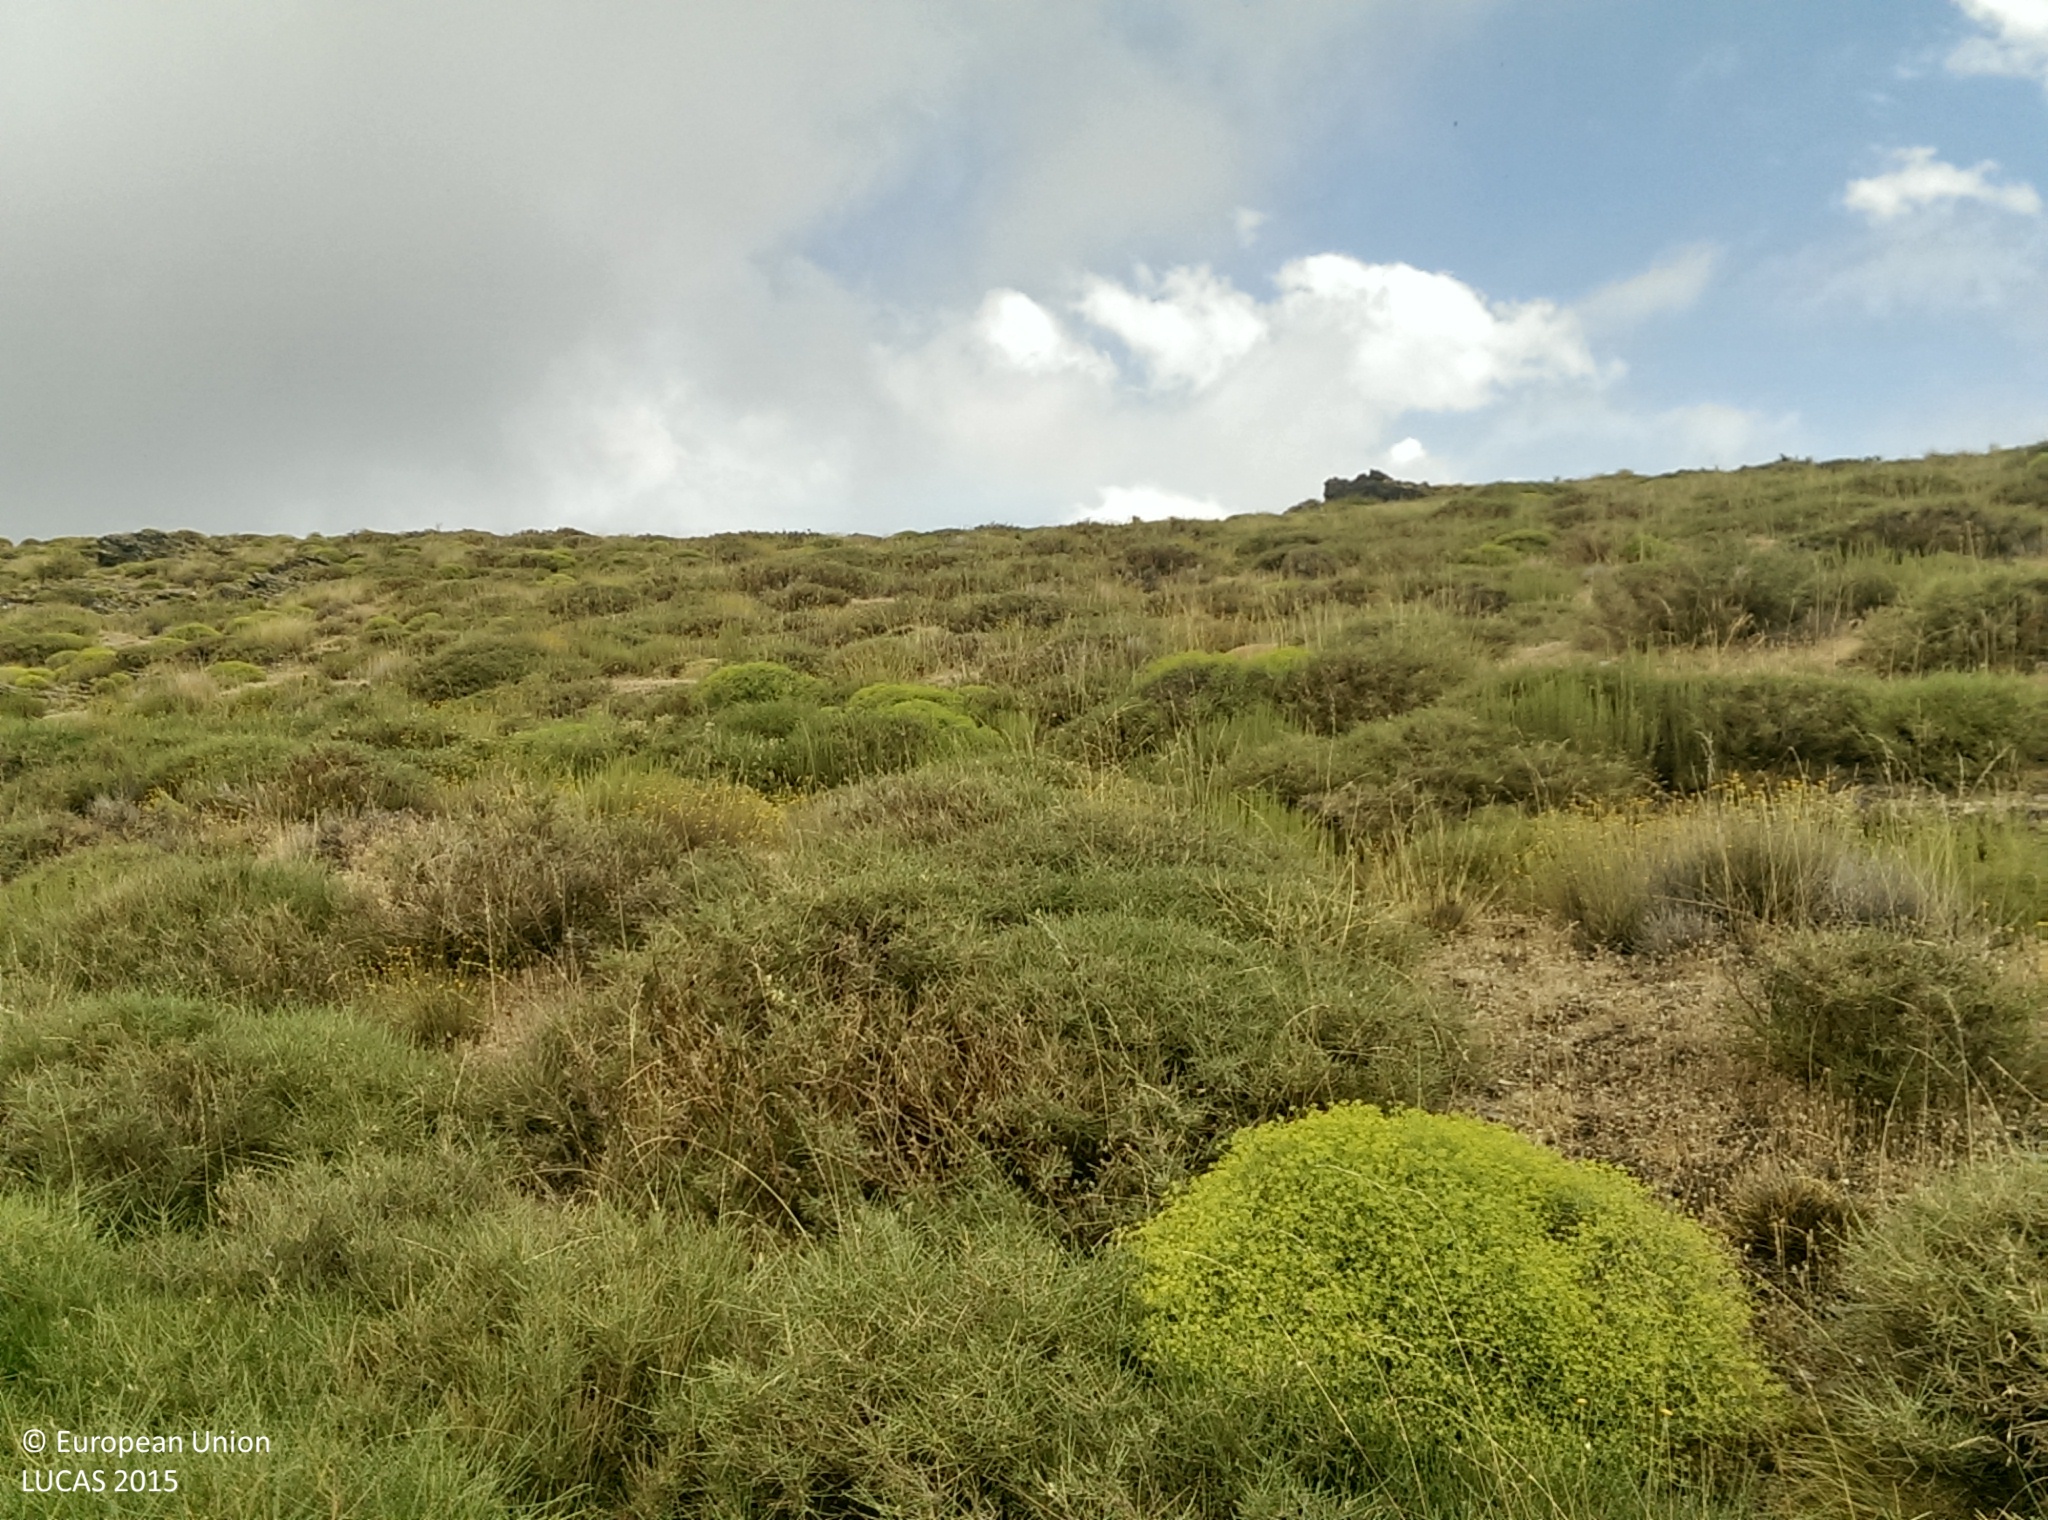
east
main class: Shrubland
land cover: Shrubland without tree cover
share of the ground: > 75 %
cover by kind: shrubs 80 %, herbaceous plants 10 %, unconsolidated bare surface 10 %
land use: Forestry
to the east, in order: Shrubland without tree cover
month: July
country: ES
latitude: 37.0354
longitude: -3.1250
